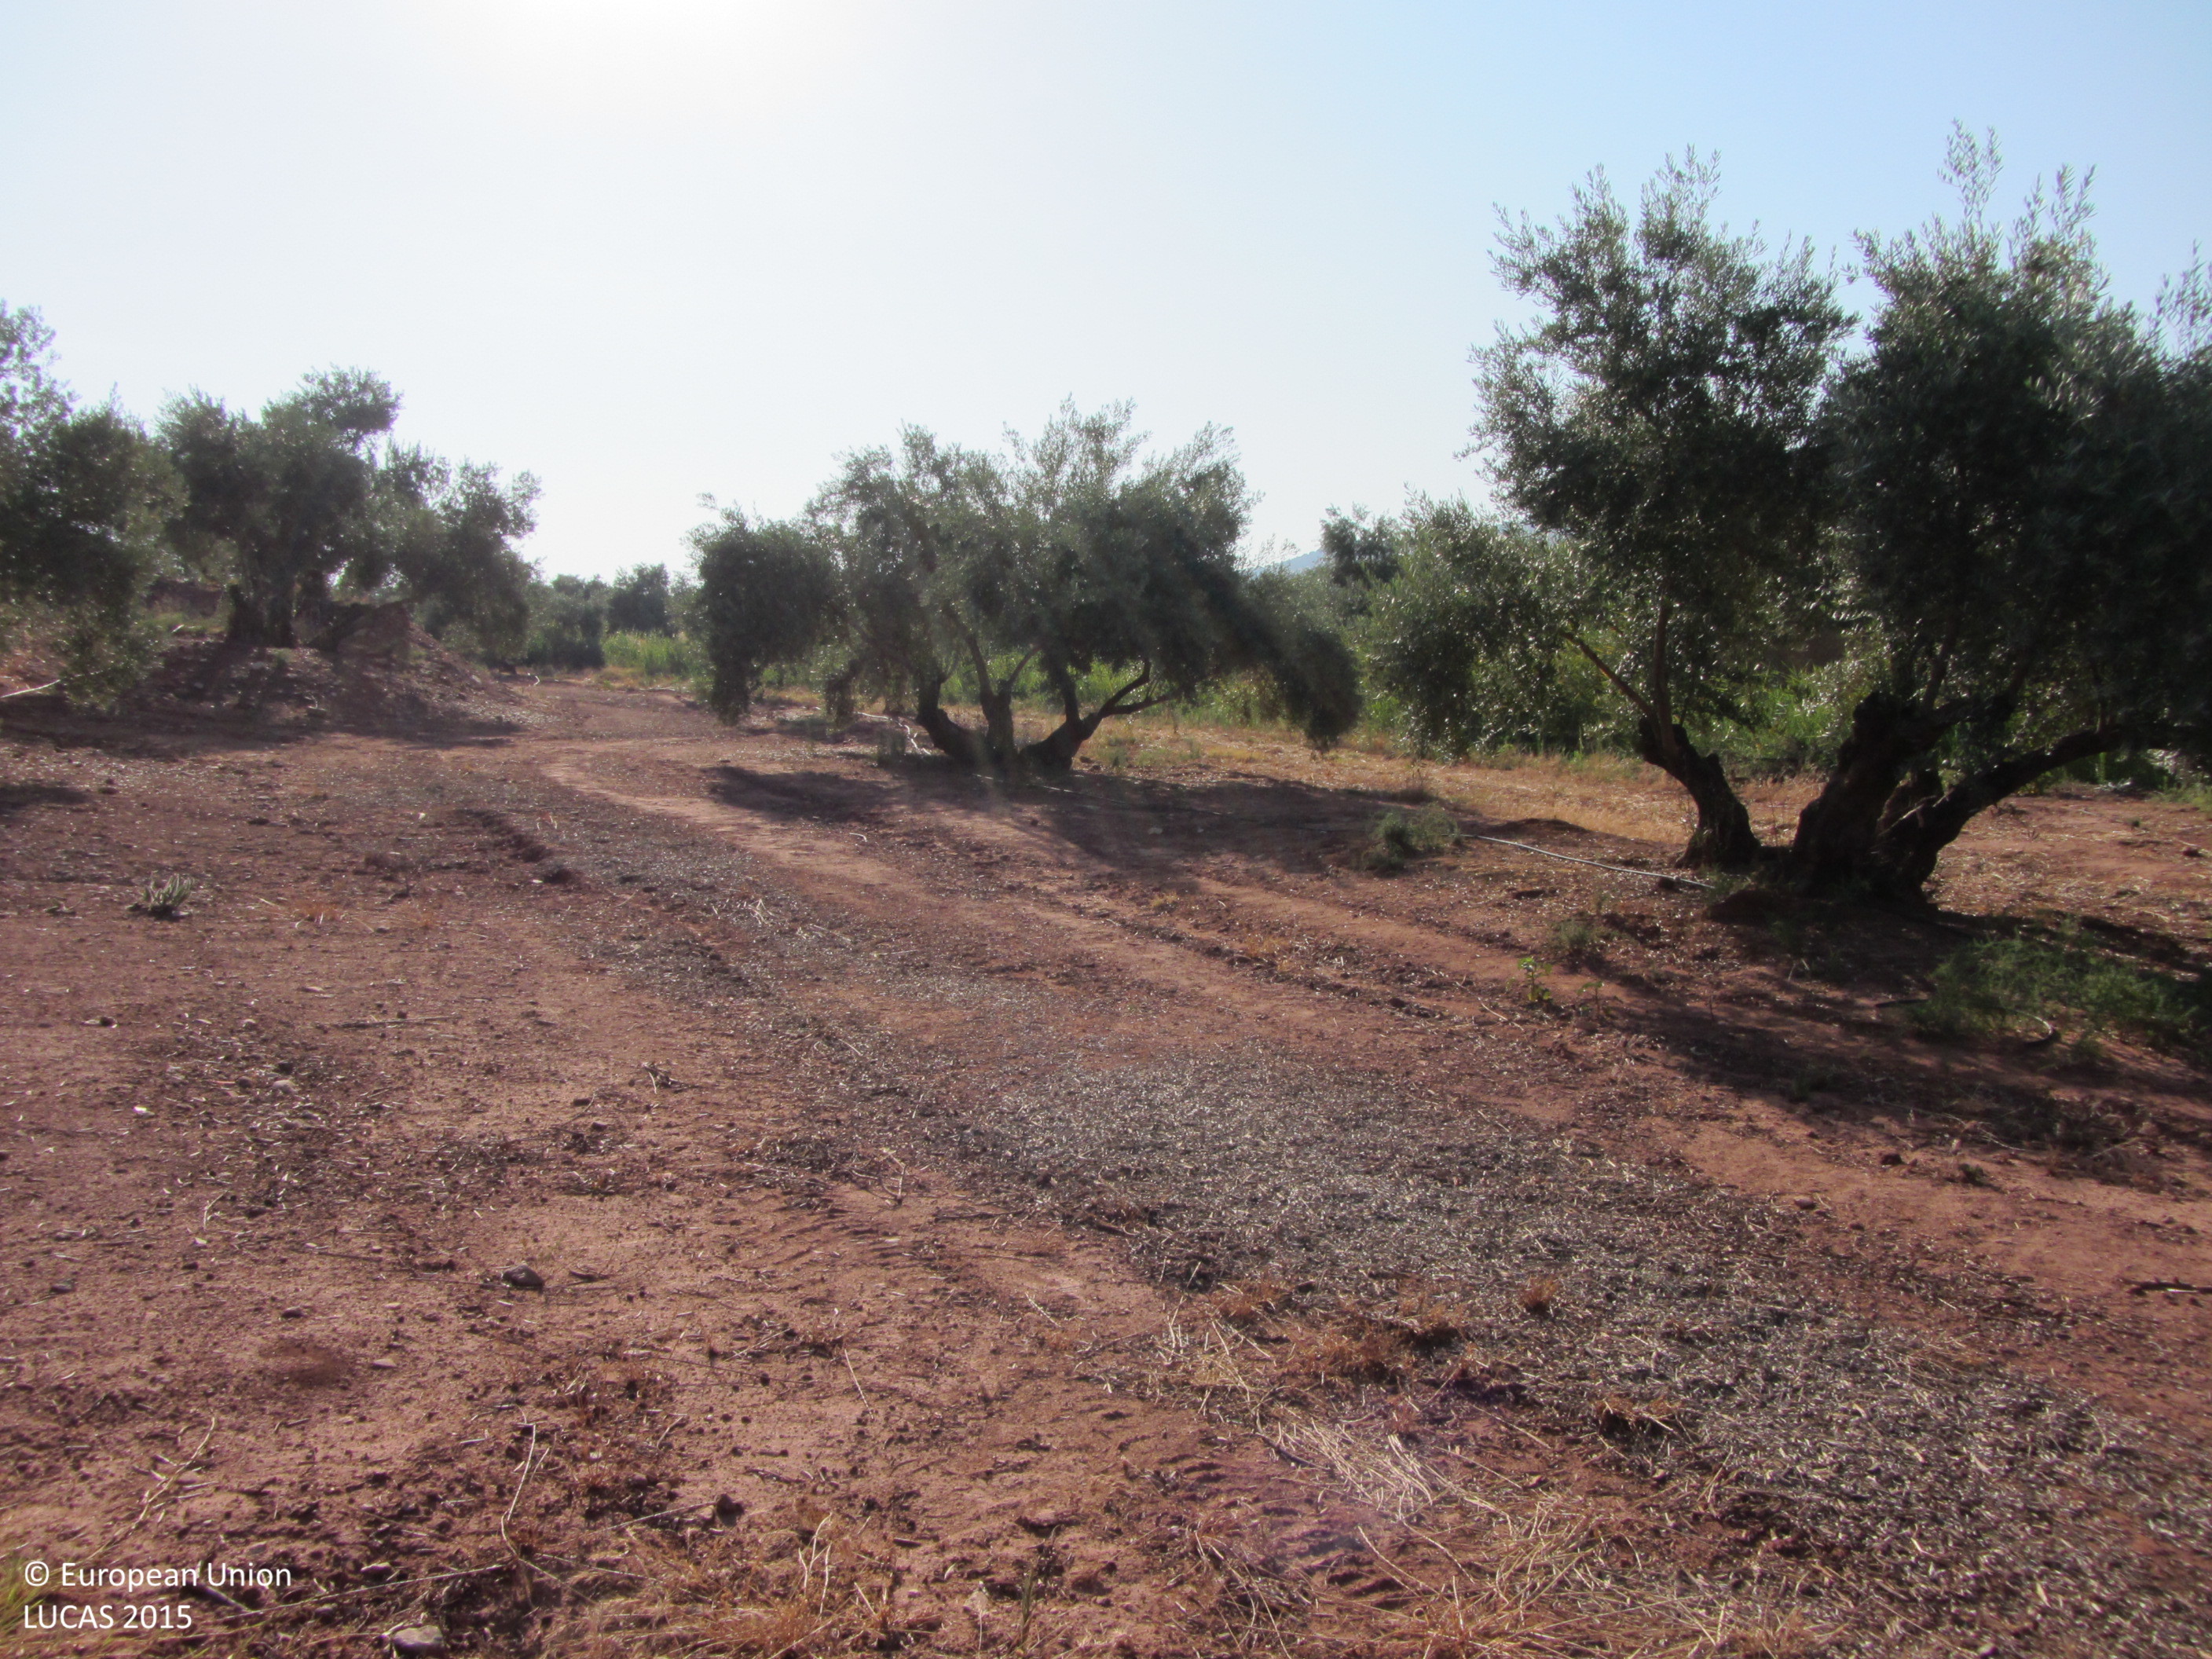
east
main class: Cropland
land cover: Olive groves
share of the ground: 25 - 50 %
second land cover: Other bare soil
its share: > 75 %
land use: Agriculture (excluding fallow land and kitchen gardens)
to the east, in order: Olive groves; Other bare soil; Grass margins; Rivers and streams; Grass margins; Olive groves
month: June
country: ES
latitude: 38.1864
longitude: -3.4180
